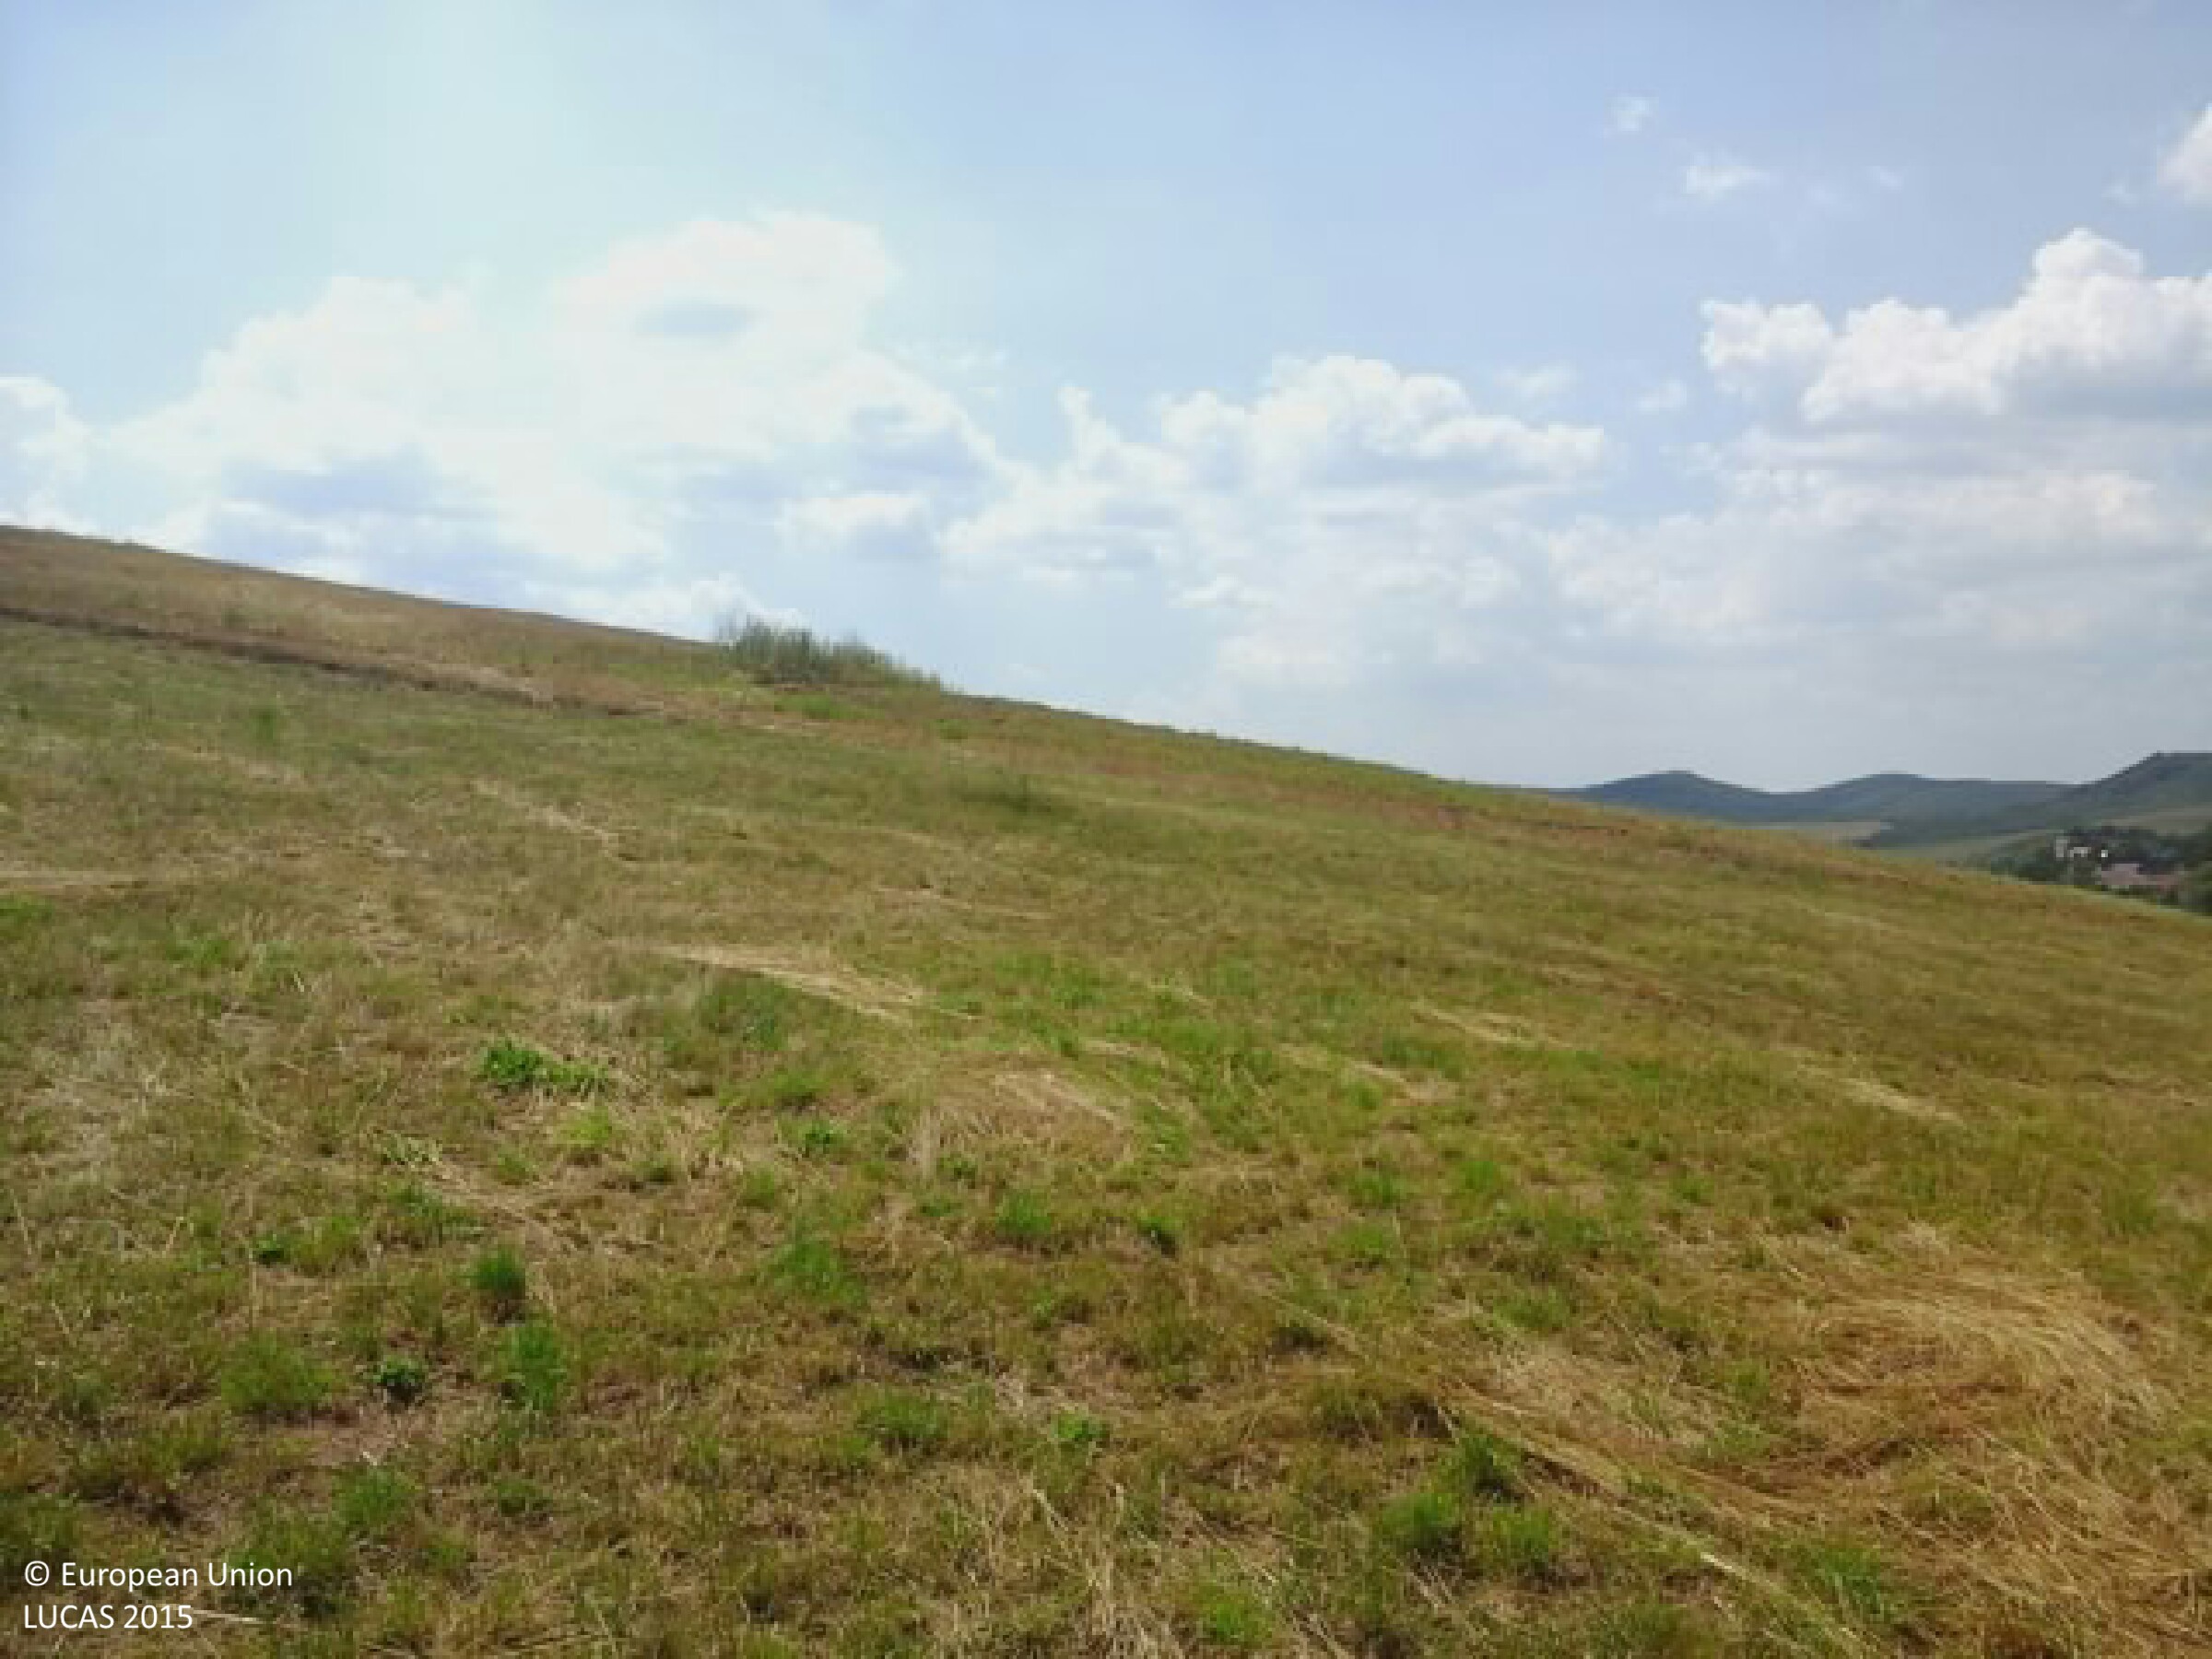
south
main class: Grassland
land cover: Grassland without tree/shrub cover
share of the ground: > 75 %
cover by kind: herbaceous plants 100 %
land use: Agriculture (excluding fallow land and kitchen gardens)
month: July
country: HU
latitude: 47.9820
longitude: 20.0365
